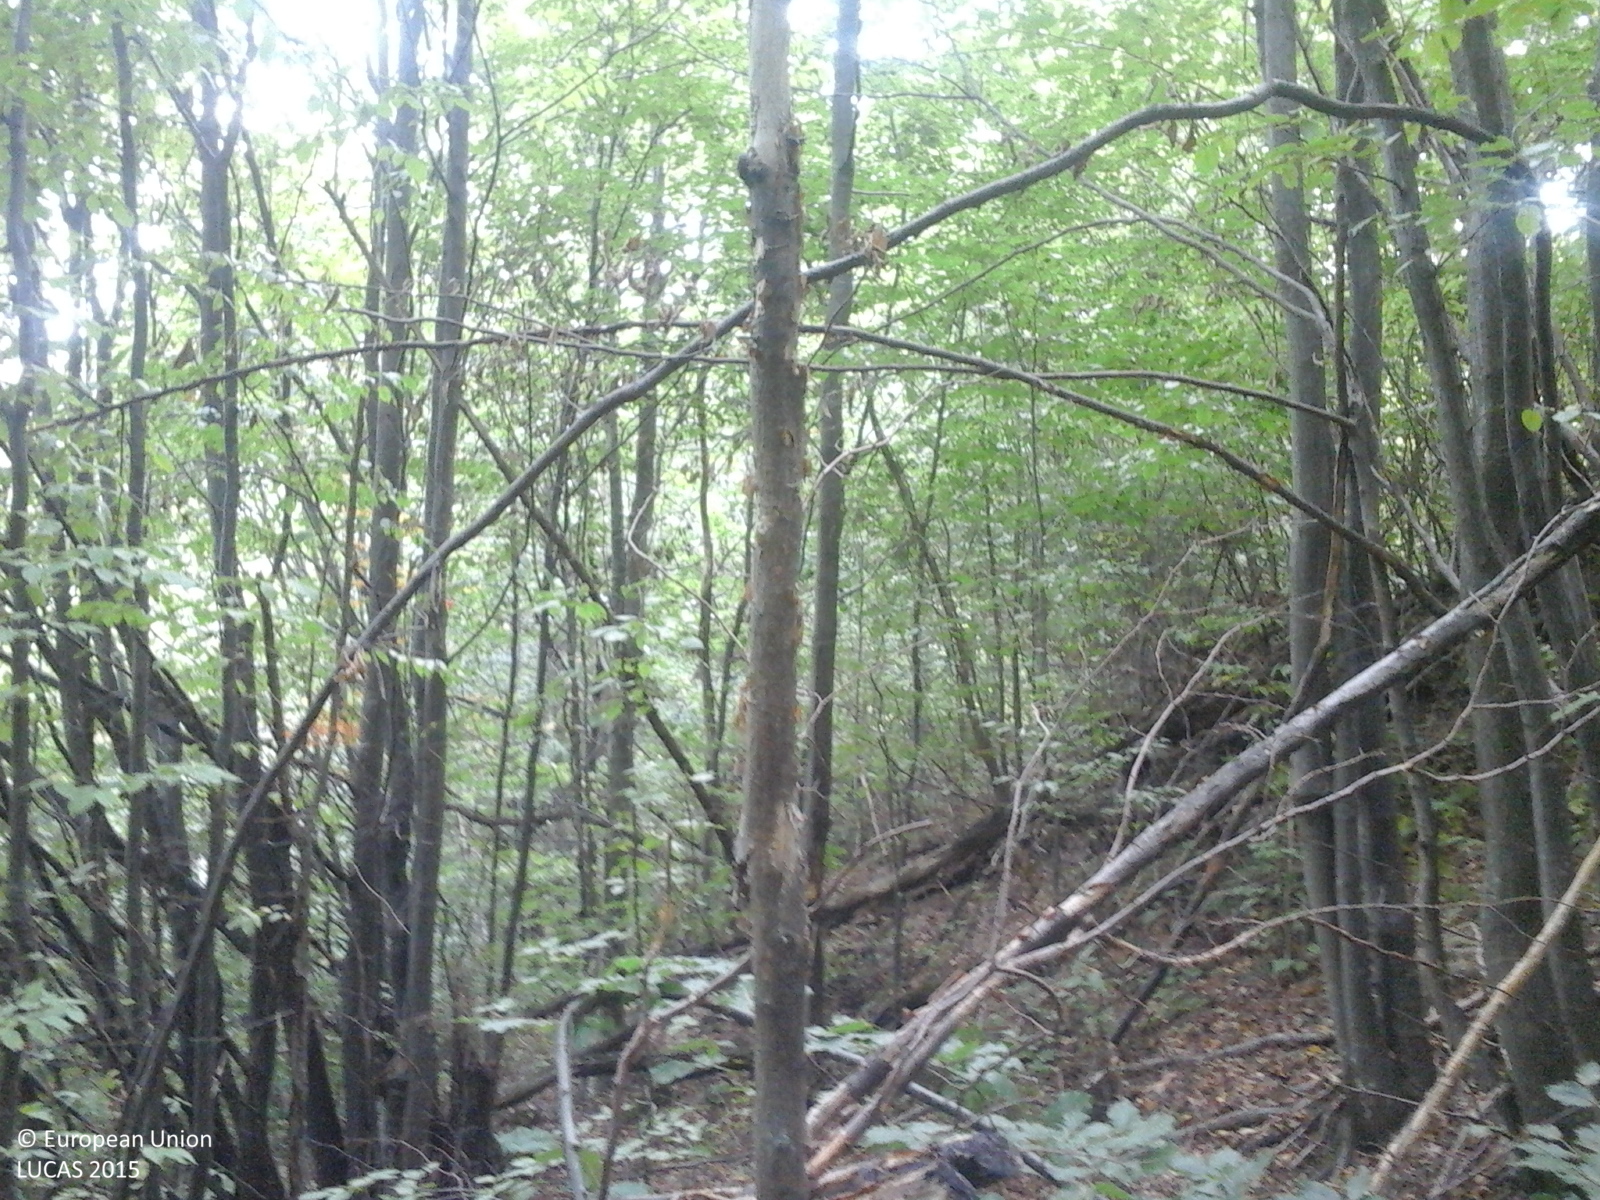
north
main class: Woodland
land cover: Broadleaved woodland
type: beech forest
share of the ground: > 75 %
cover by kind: broadleaved forest trees 100 %
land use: Forestry
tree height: > 5 m
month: September
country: RO
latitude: 45.0145
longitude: 22.4899
